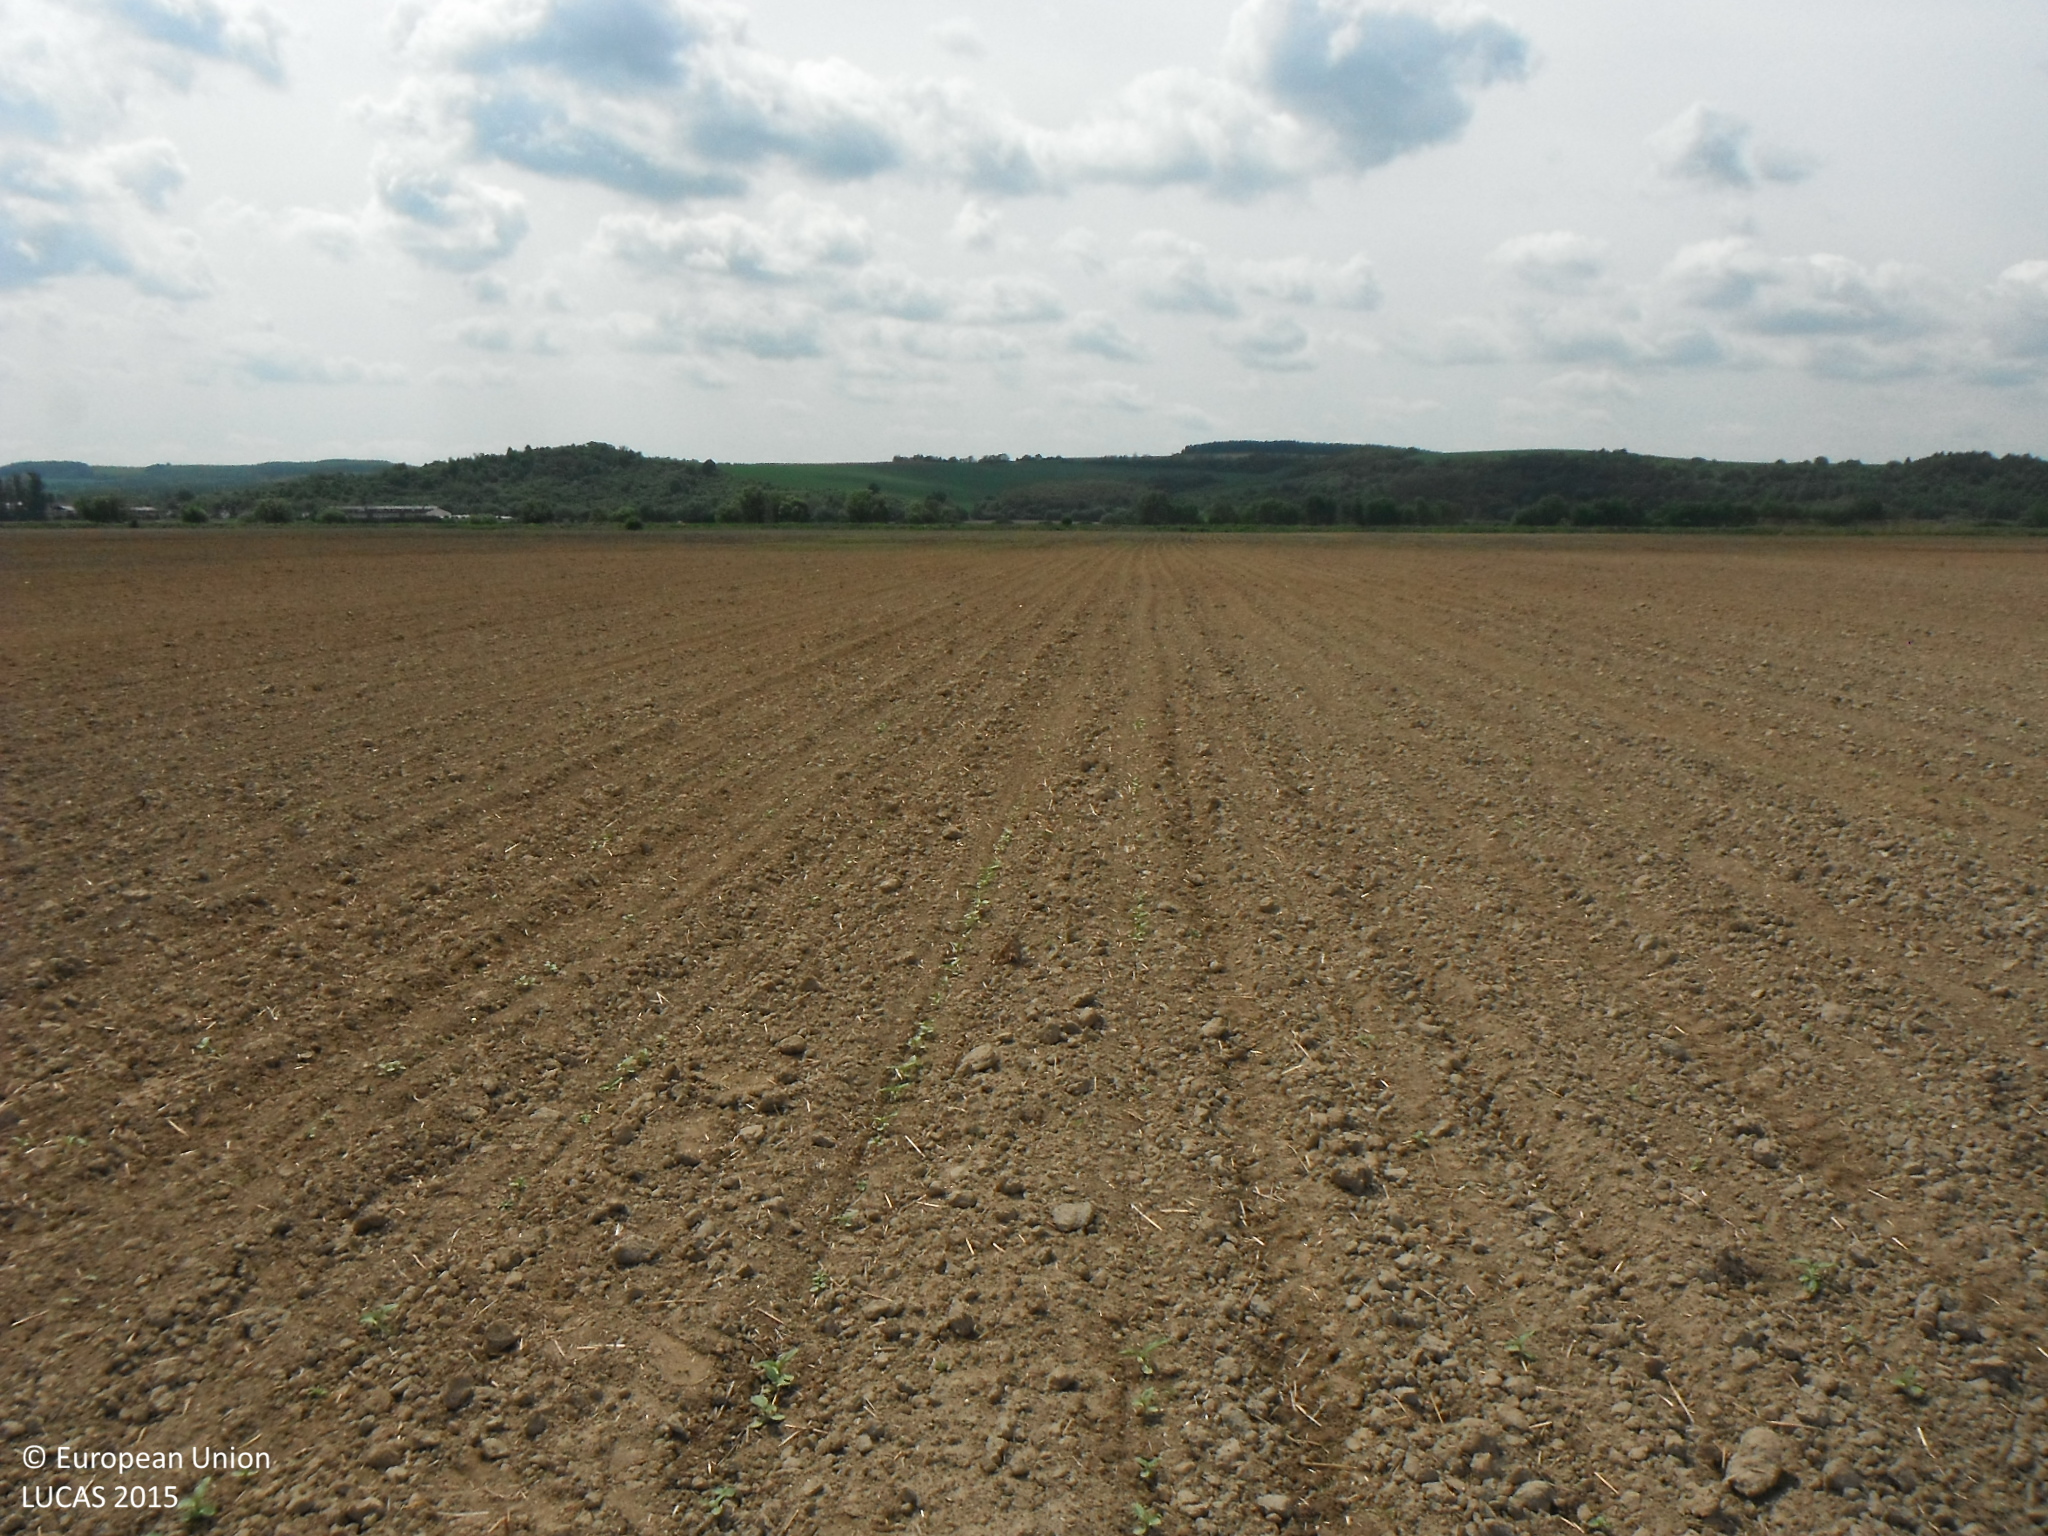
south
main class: Cropland
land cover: Sunflower
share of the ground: < 10 %
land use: Agriculture (excluding fallow land and kitchen gardens)
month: May
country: SK
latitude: 48.5581
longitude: 21.0296
